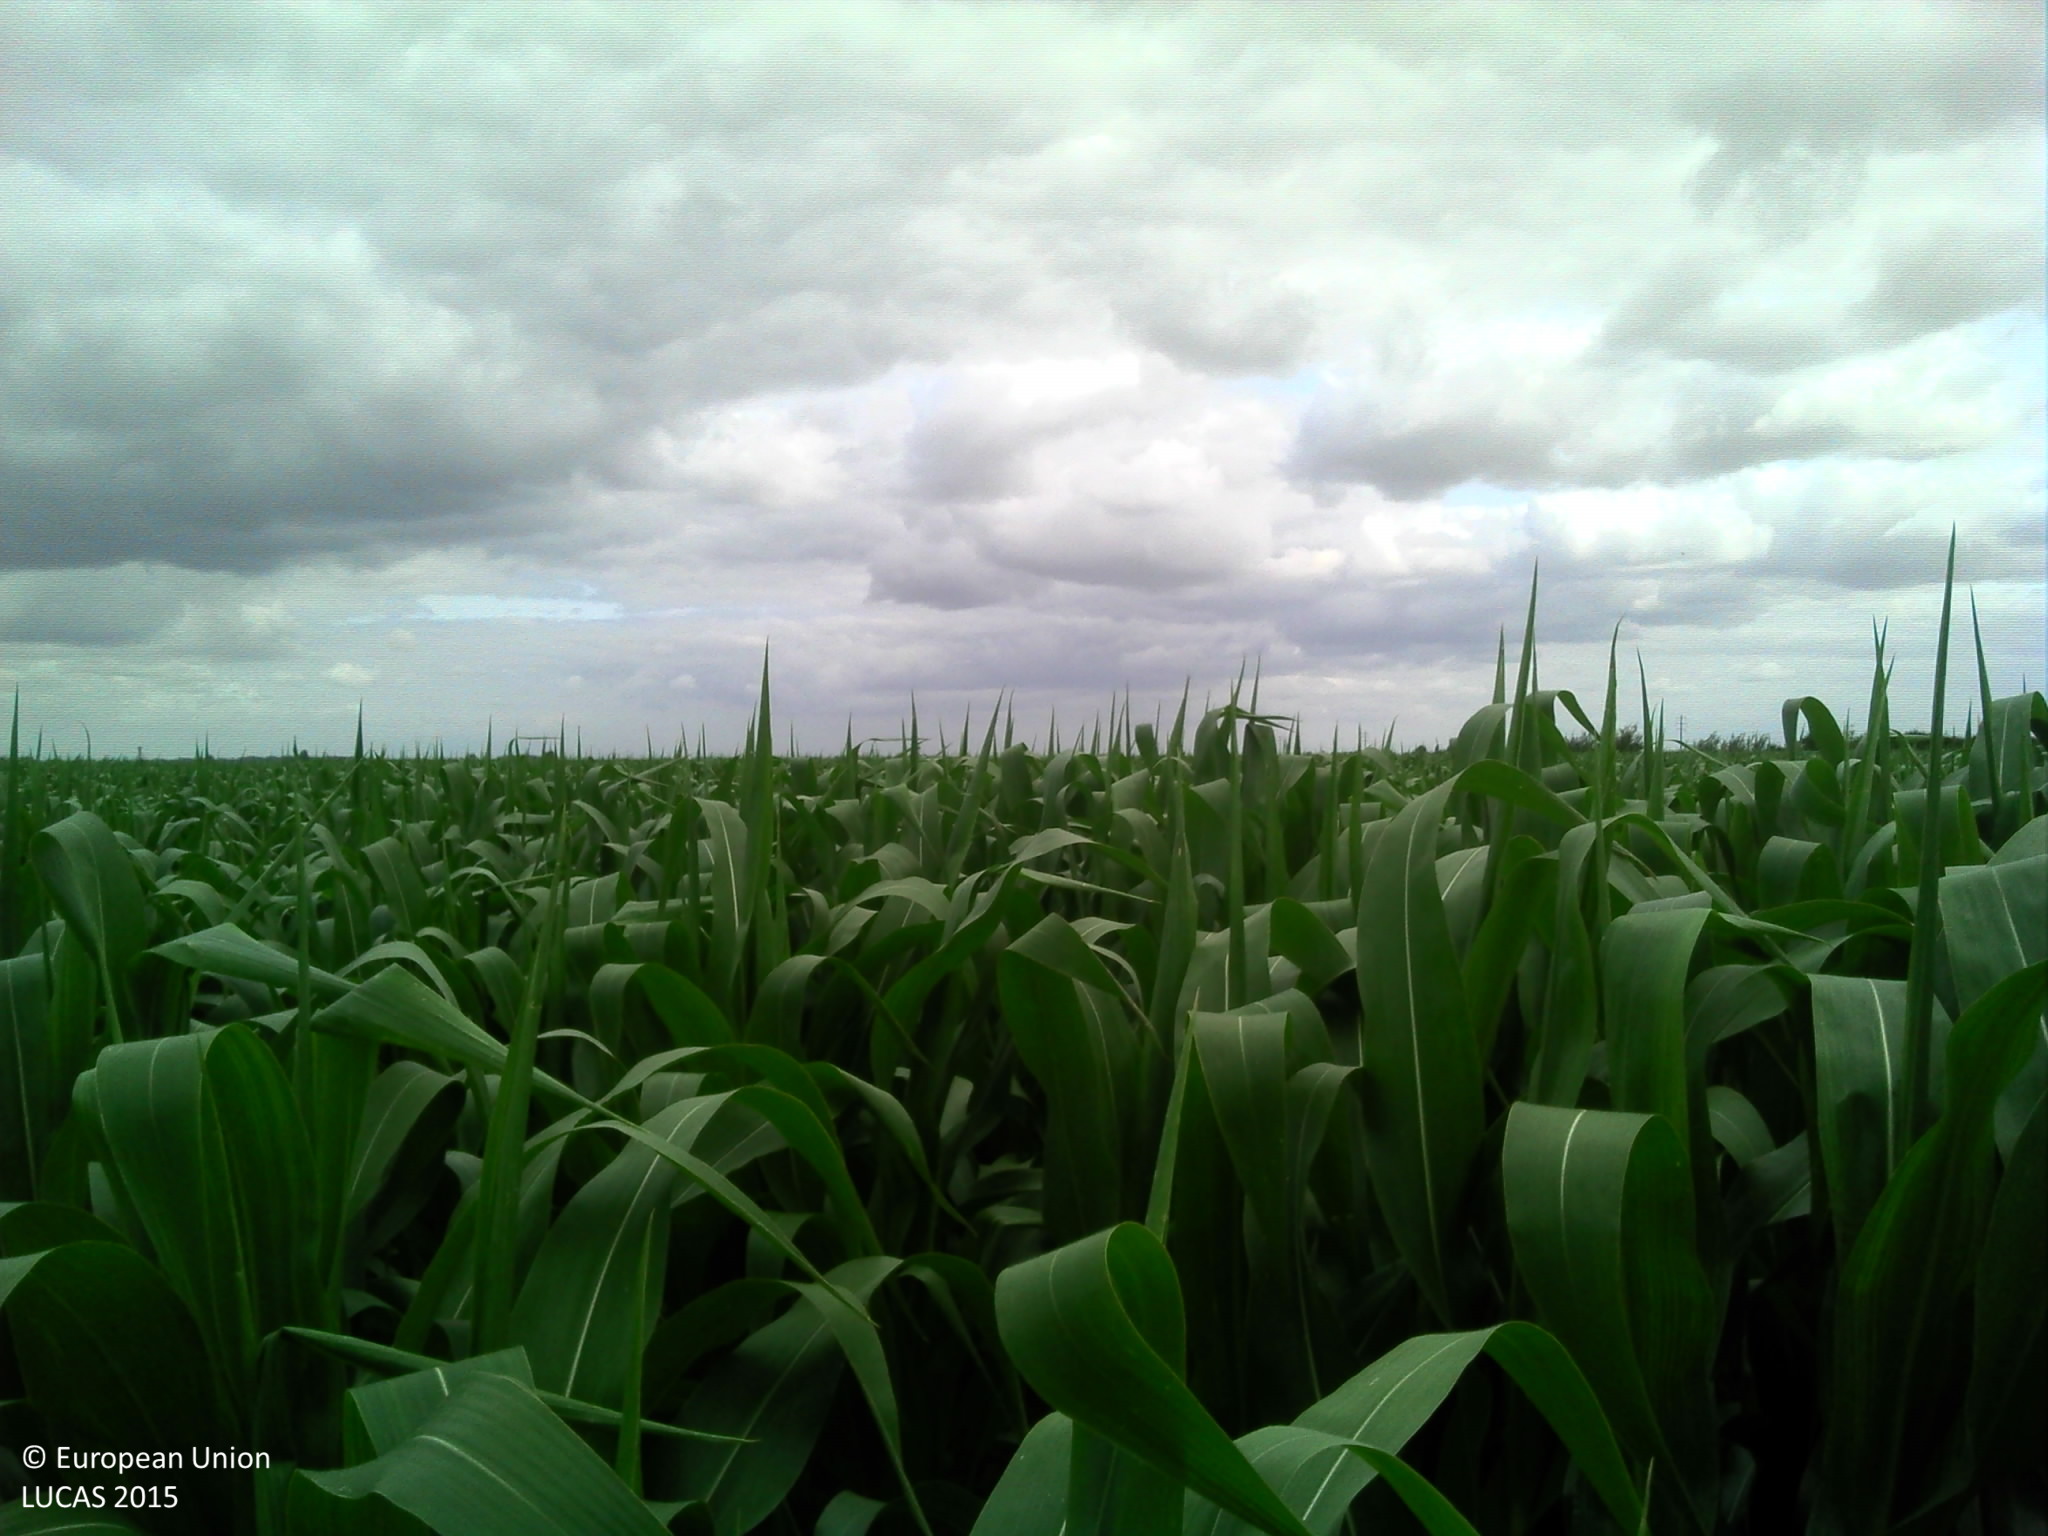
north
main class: Cropland
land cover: Maize
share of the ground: > 75 %
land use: Agriculture (excluding fallow land and kitchen gardens)
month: July
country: FR
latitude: 46.3830
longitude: -1.3343
